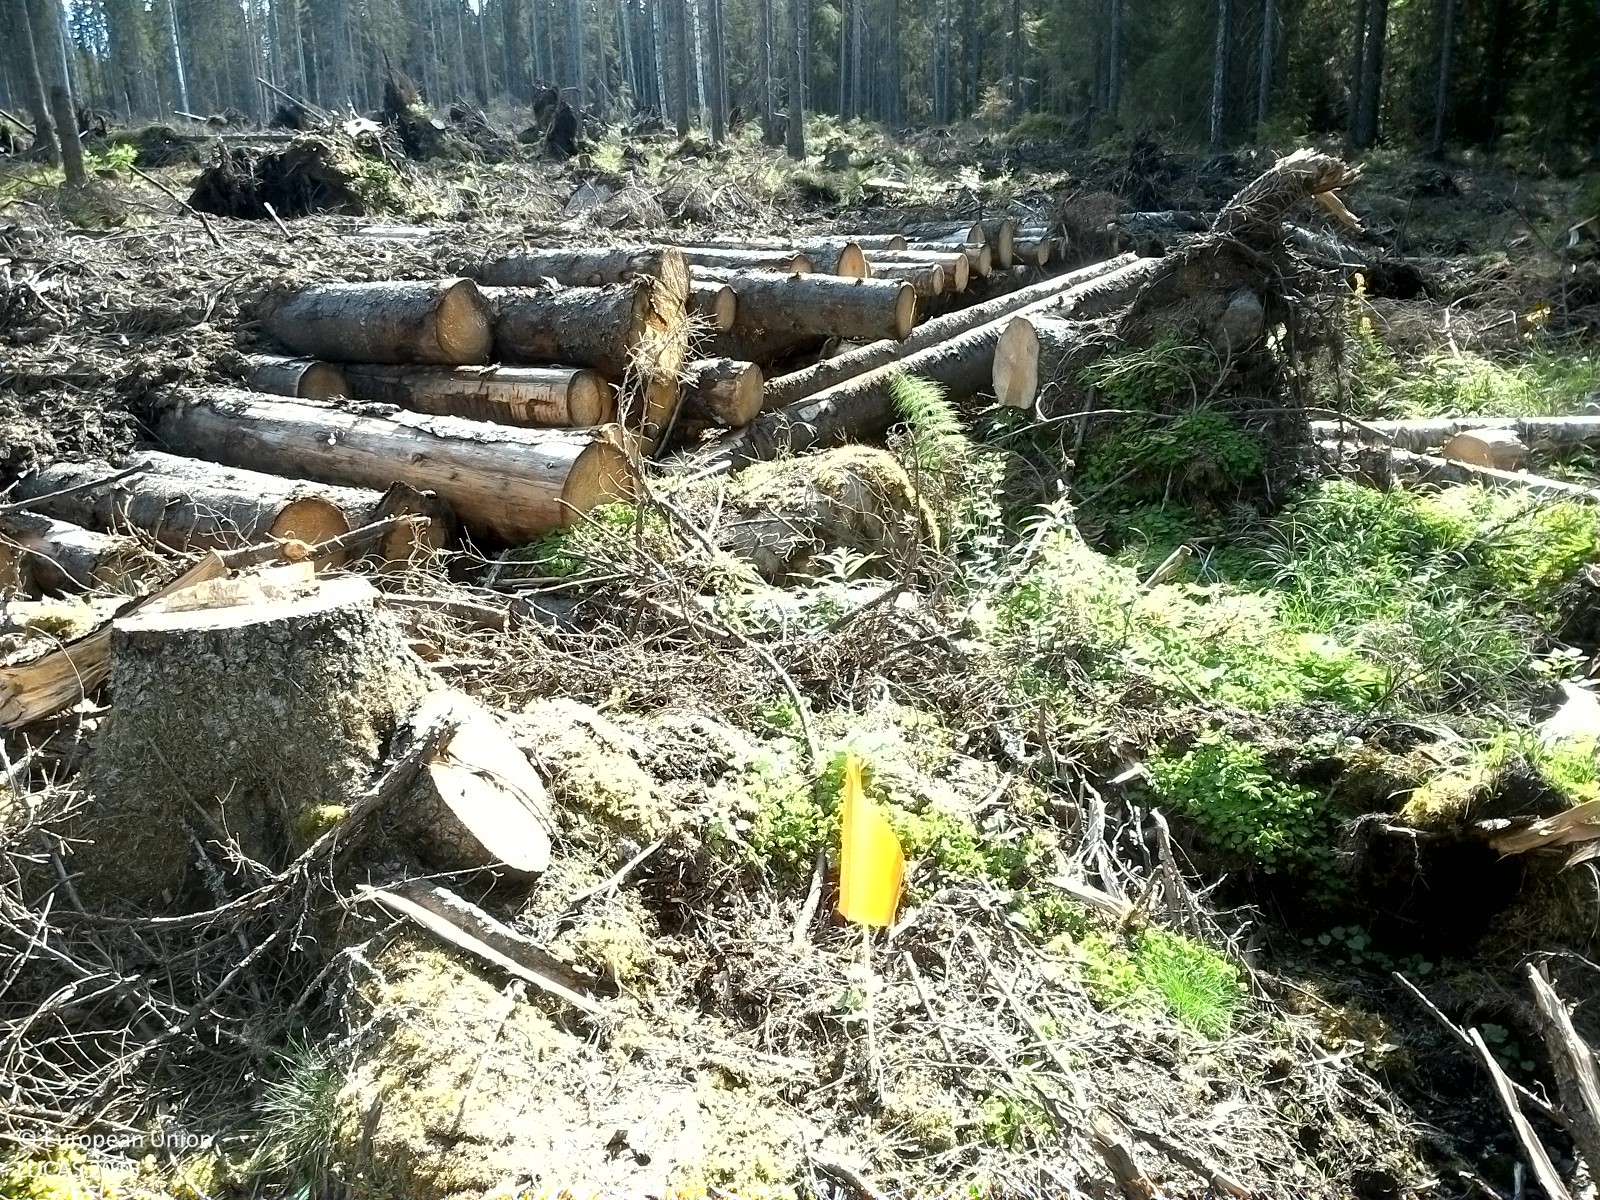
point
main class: Woodland
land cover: Spruce dominated coniferous woodland
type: boreal forest
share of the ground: 10 - 25 %
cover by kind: herbaceous plants 30 %, unconsolidated bare surface 25 %, coniferous forest trees 15 %, shrubs 15 %, lichens and mosses 15 %
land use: Forestry
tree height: > 5 m
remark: Clear cut
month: August
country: SE
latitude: 62.5806
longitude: 16.4996
